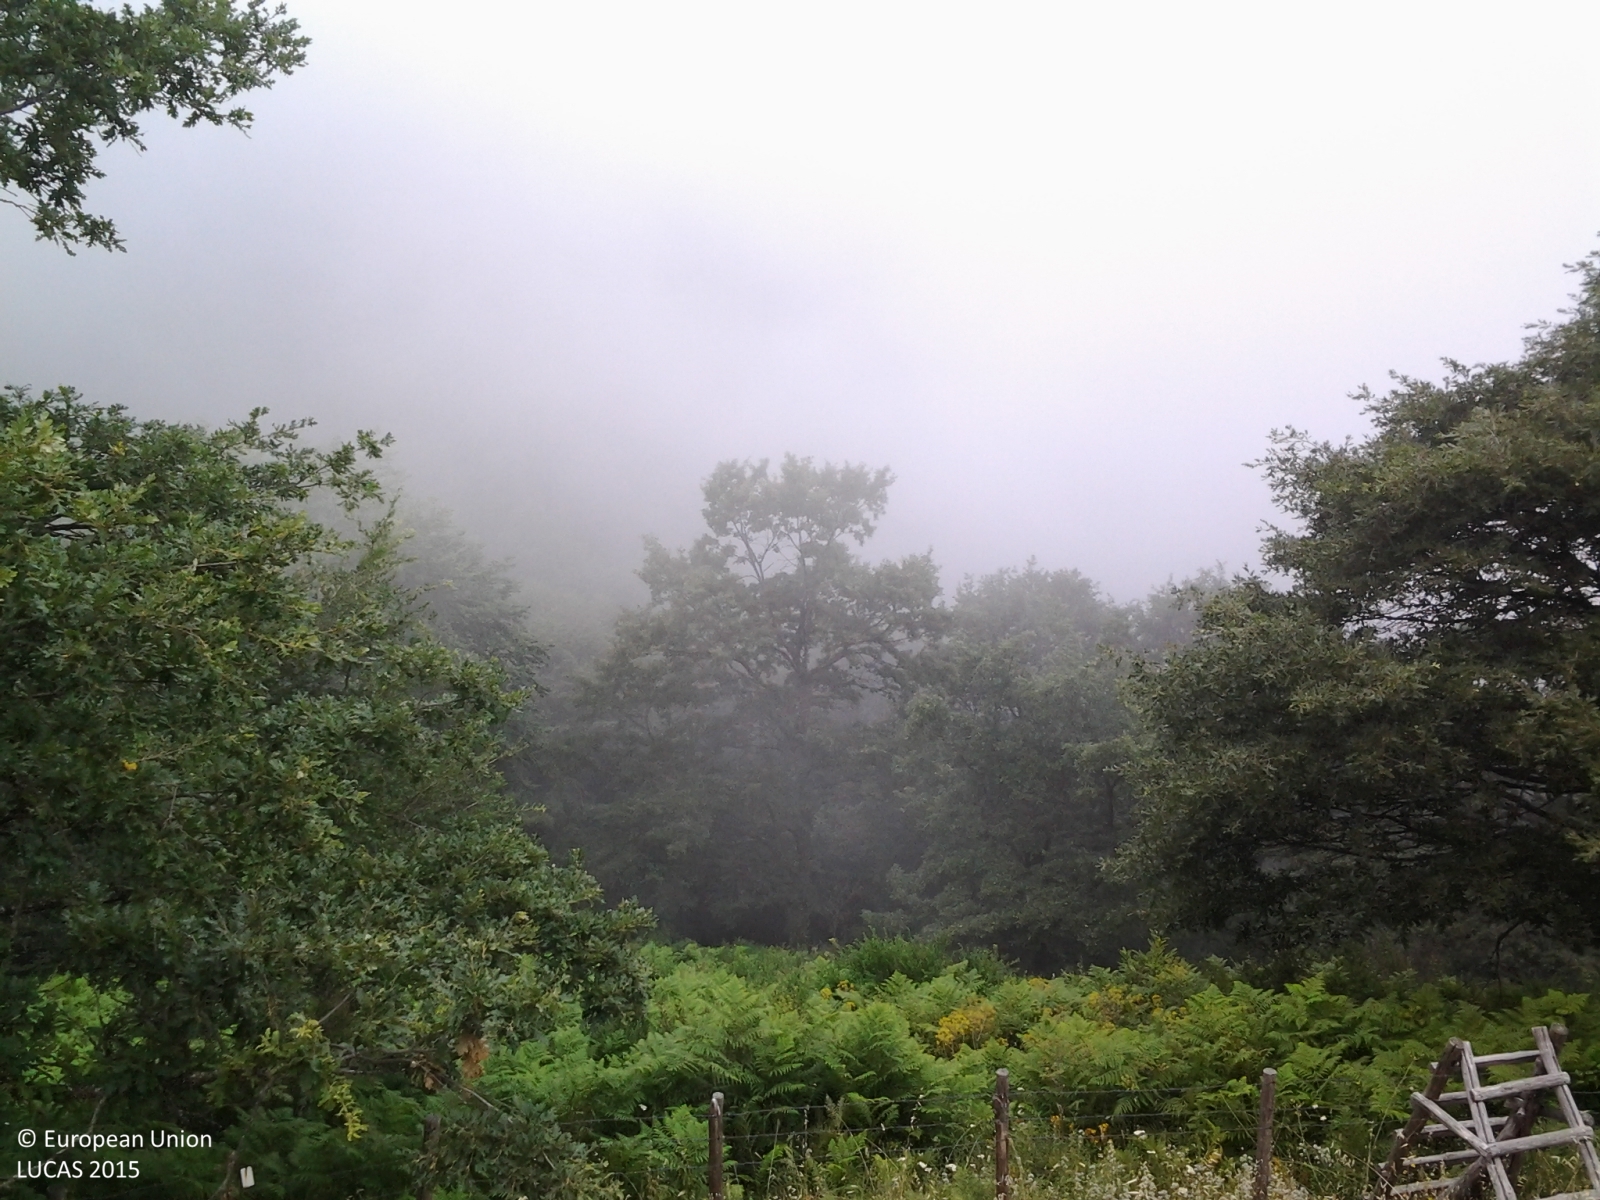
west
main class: Woodland
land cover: Broadleaved woodland
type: thermophilous deciduous forest
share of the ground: > 75 %
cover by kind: broadleaved forest trees 90 %, shrubs 5 %, herbaceous plants 5 %
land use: Amenities, museums, leisure
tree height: > 5 m
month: July
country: IT
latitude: 37.9861
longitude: 14.8745
